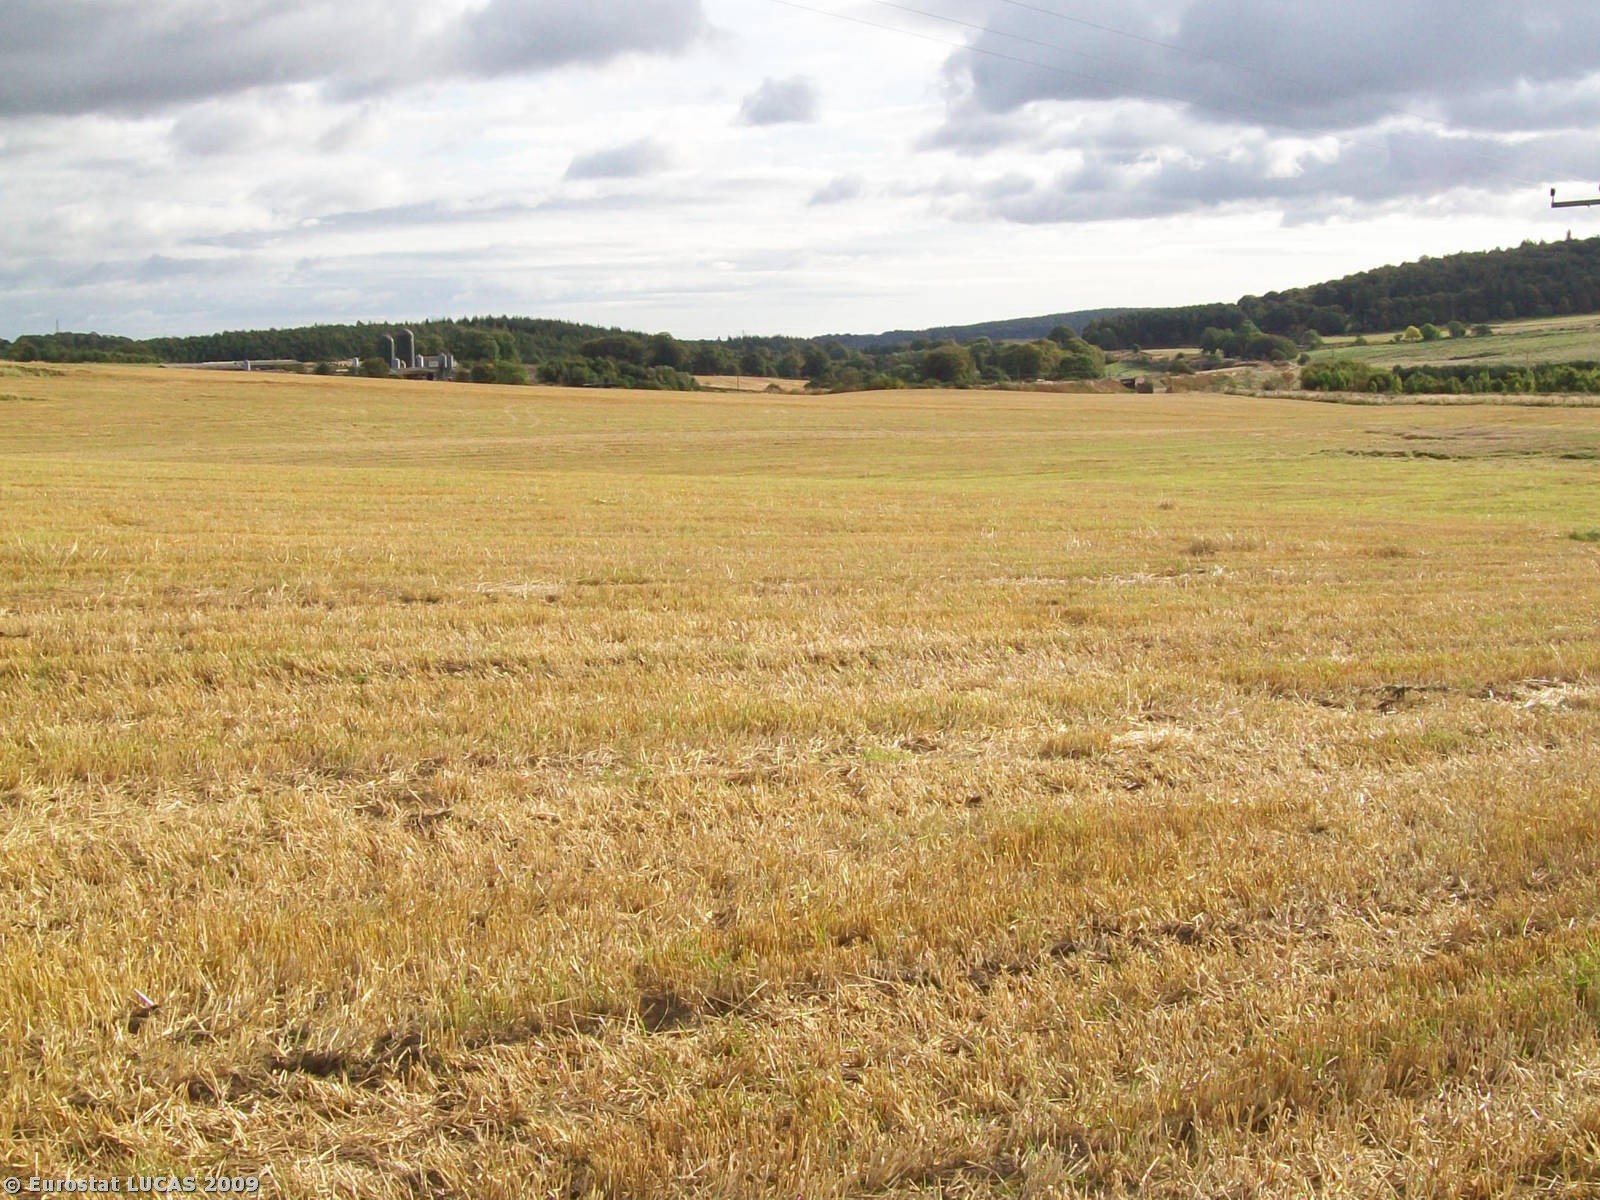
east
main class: Cropland
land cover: Barley
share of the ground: < 10 %
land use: Agriculture (excluding fallow land and kitchen gardens)
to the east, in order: Barley; Electric lines; Barley
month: September
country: GB
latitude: 57.3207
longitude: -2.5250
